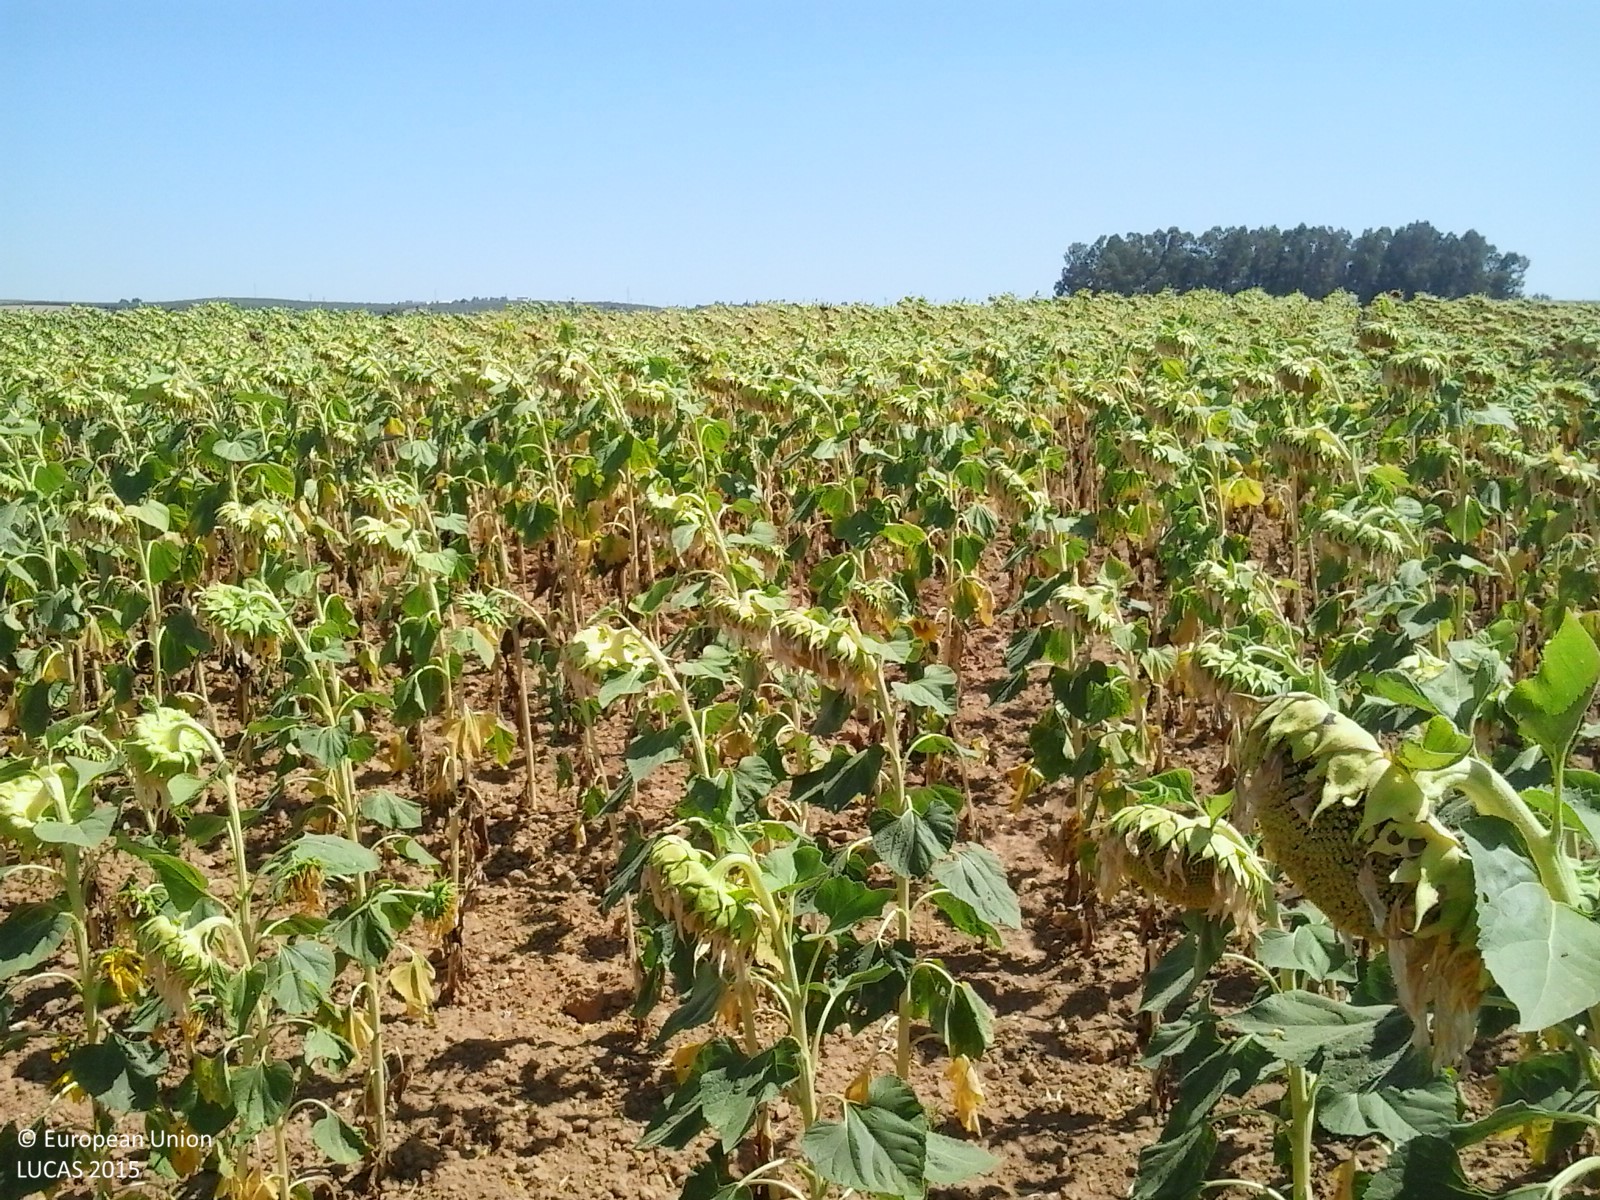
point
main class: Cropland
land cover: Sunflower
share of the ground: > 75 %
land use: Agriculture (excluding fallow land and kitchen gardens)
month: June
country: ES
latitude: 37.3843
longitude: -6.3957
